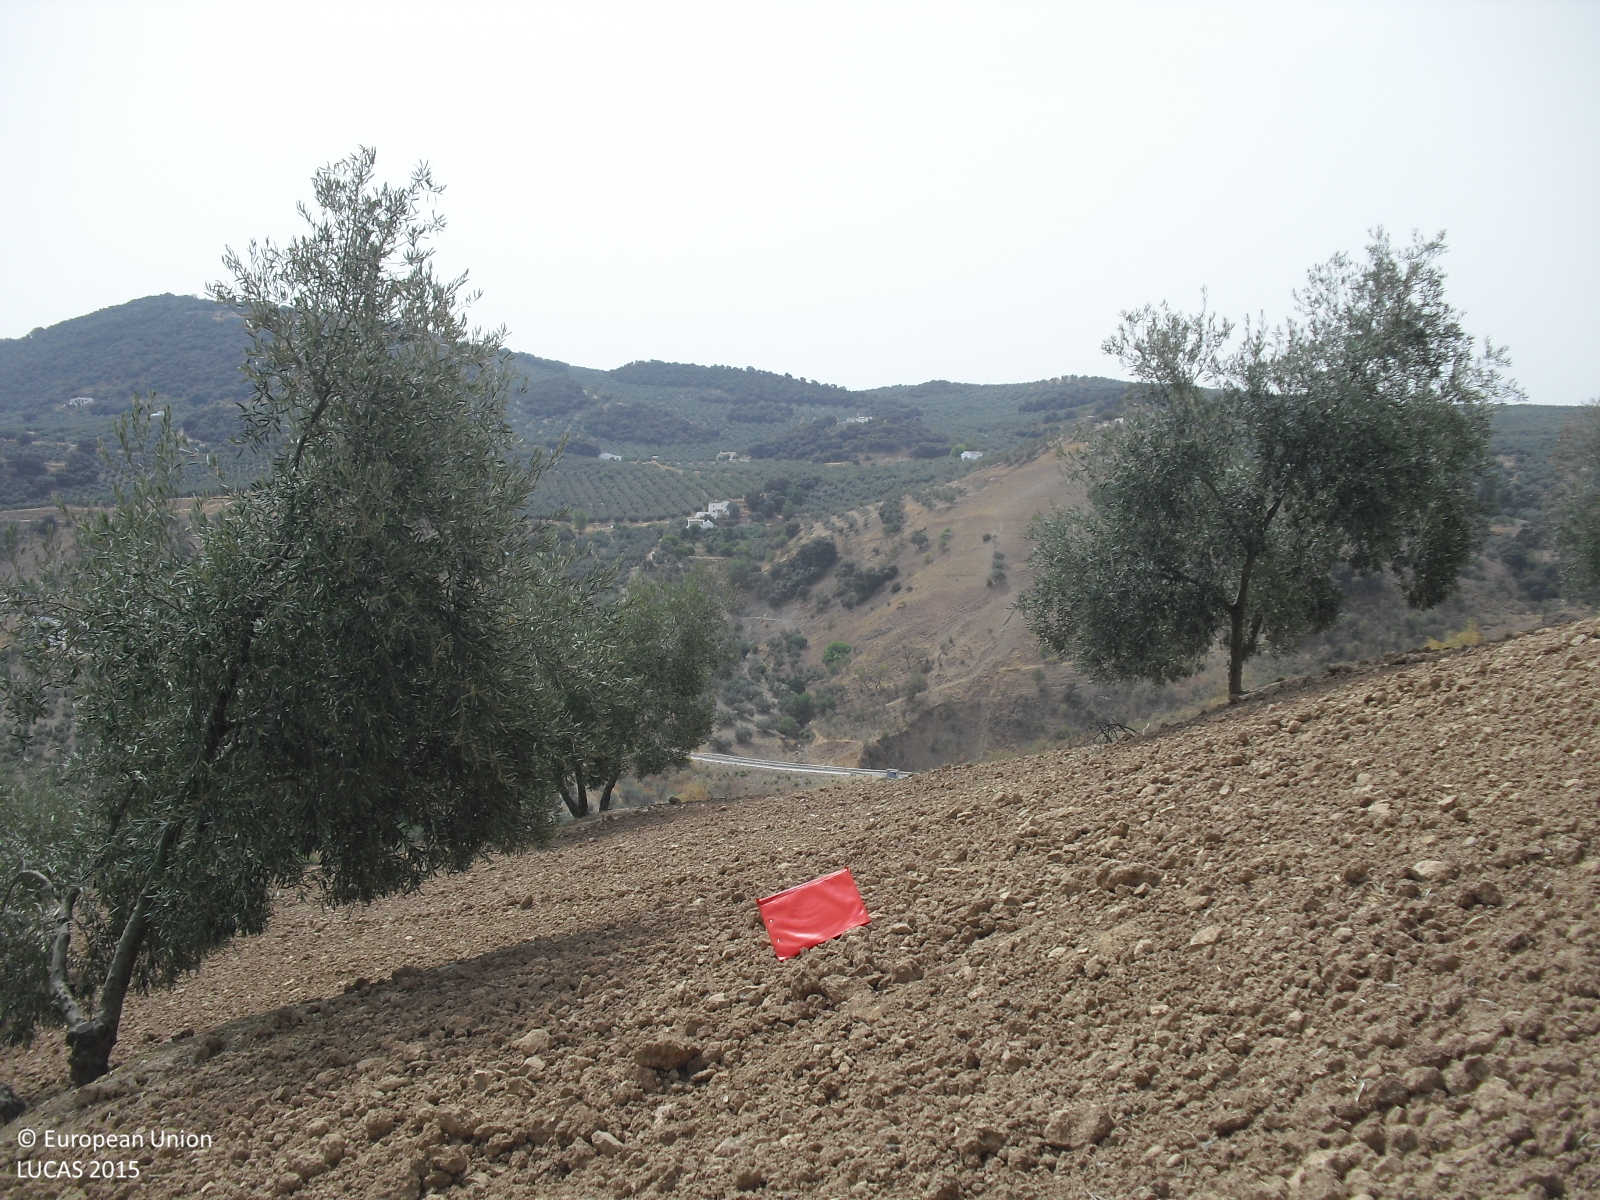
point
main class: Cropland
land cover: Olive groves
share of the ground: 25 - 50 %
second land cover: Other bare soil
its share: > 75 %
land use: Agriculture (excluding fallow land and kitchen gardens)
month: August
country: ES
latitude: 37.2094
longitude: -4.3188
